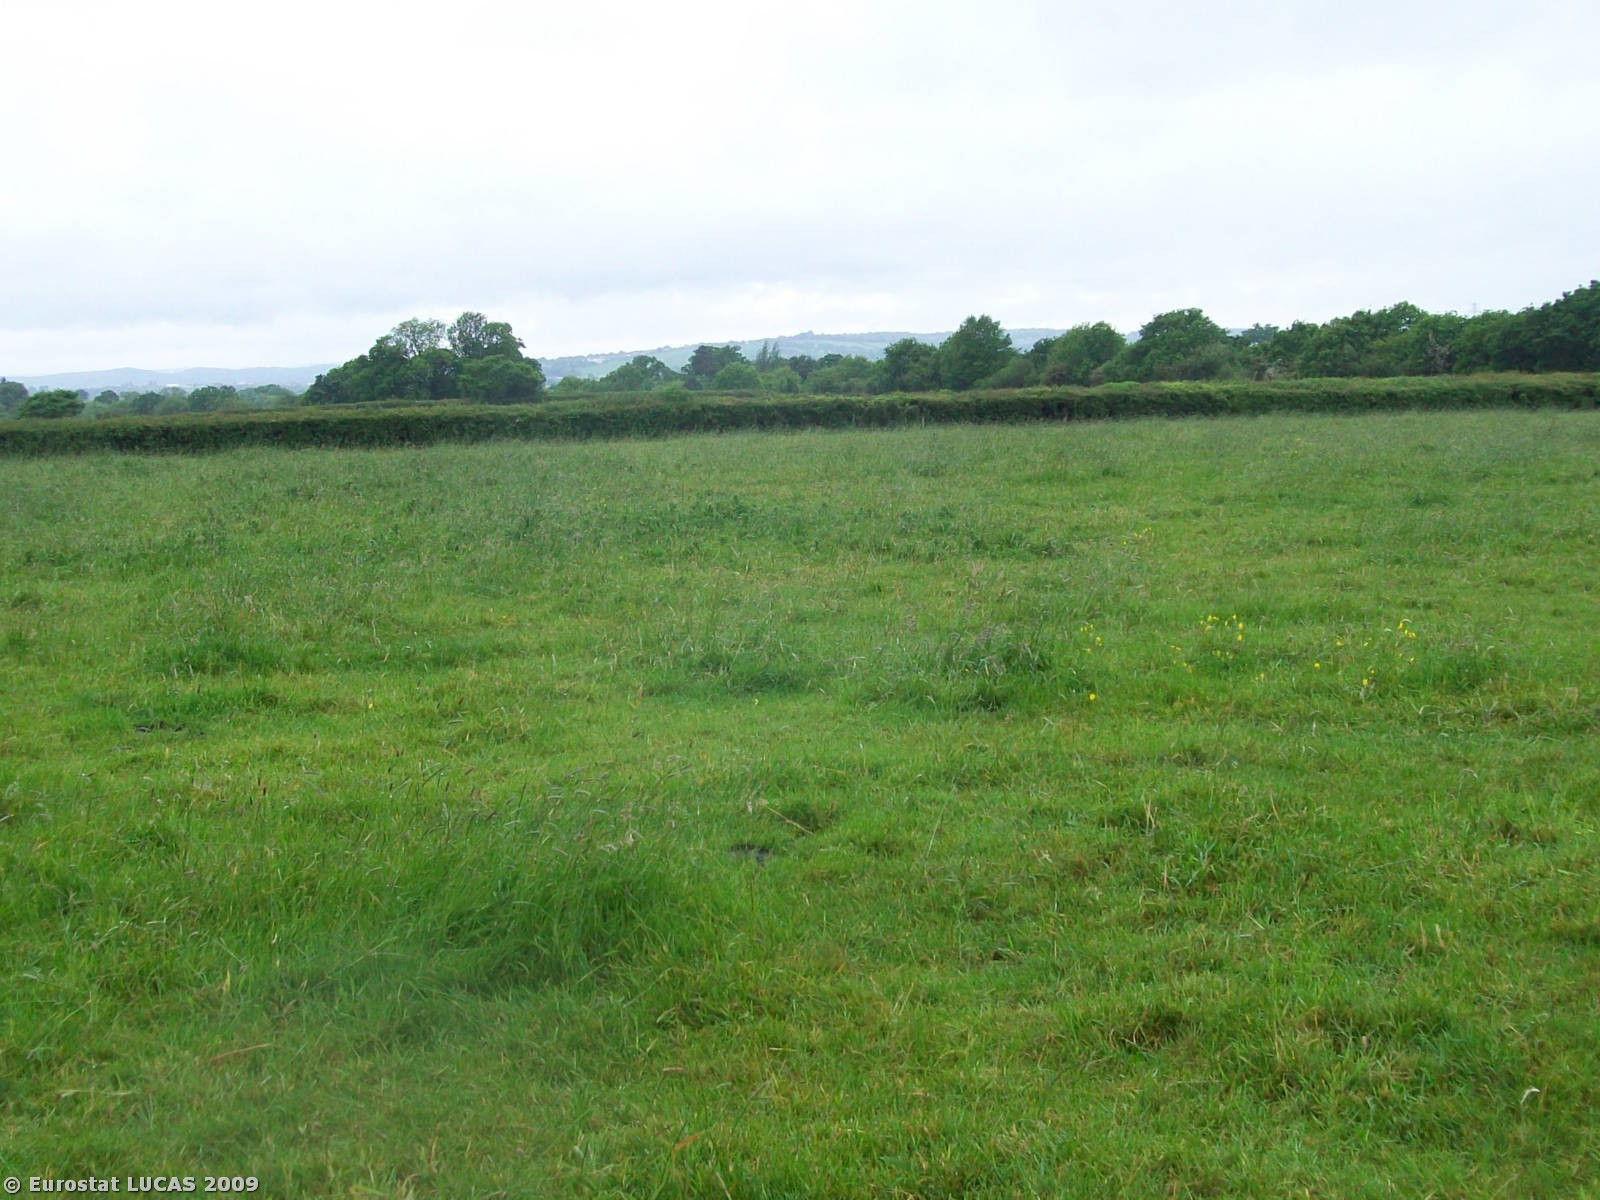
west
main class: Grassland
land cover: Grassland without tree/shrub cover
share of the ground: > 75 %
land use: Agriculture (excluding fallow land and kitchen gardens)
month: May
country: GB
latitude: 50.7570
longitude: -3.3928
